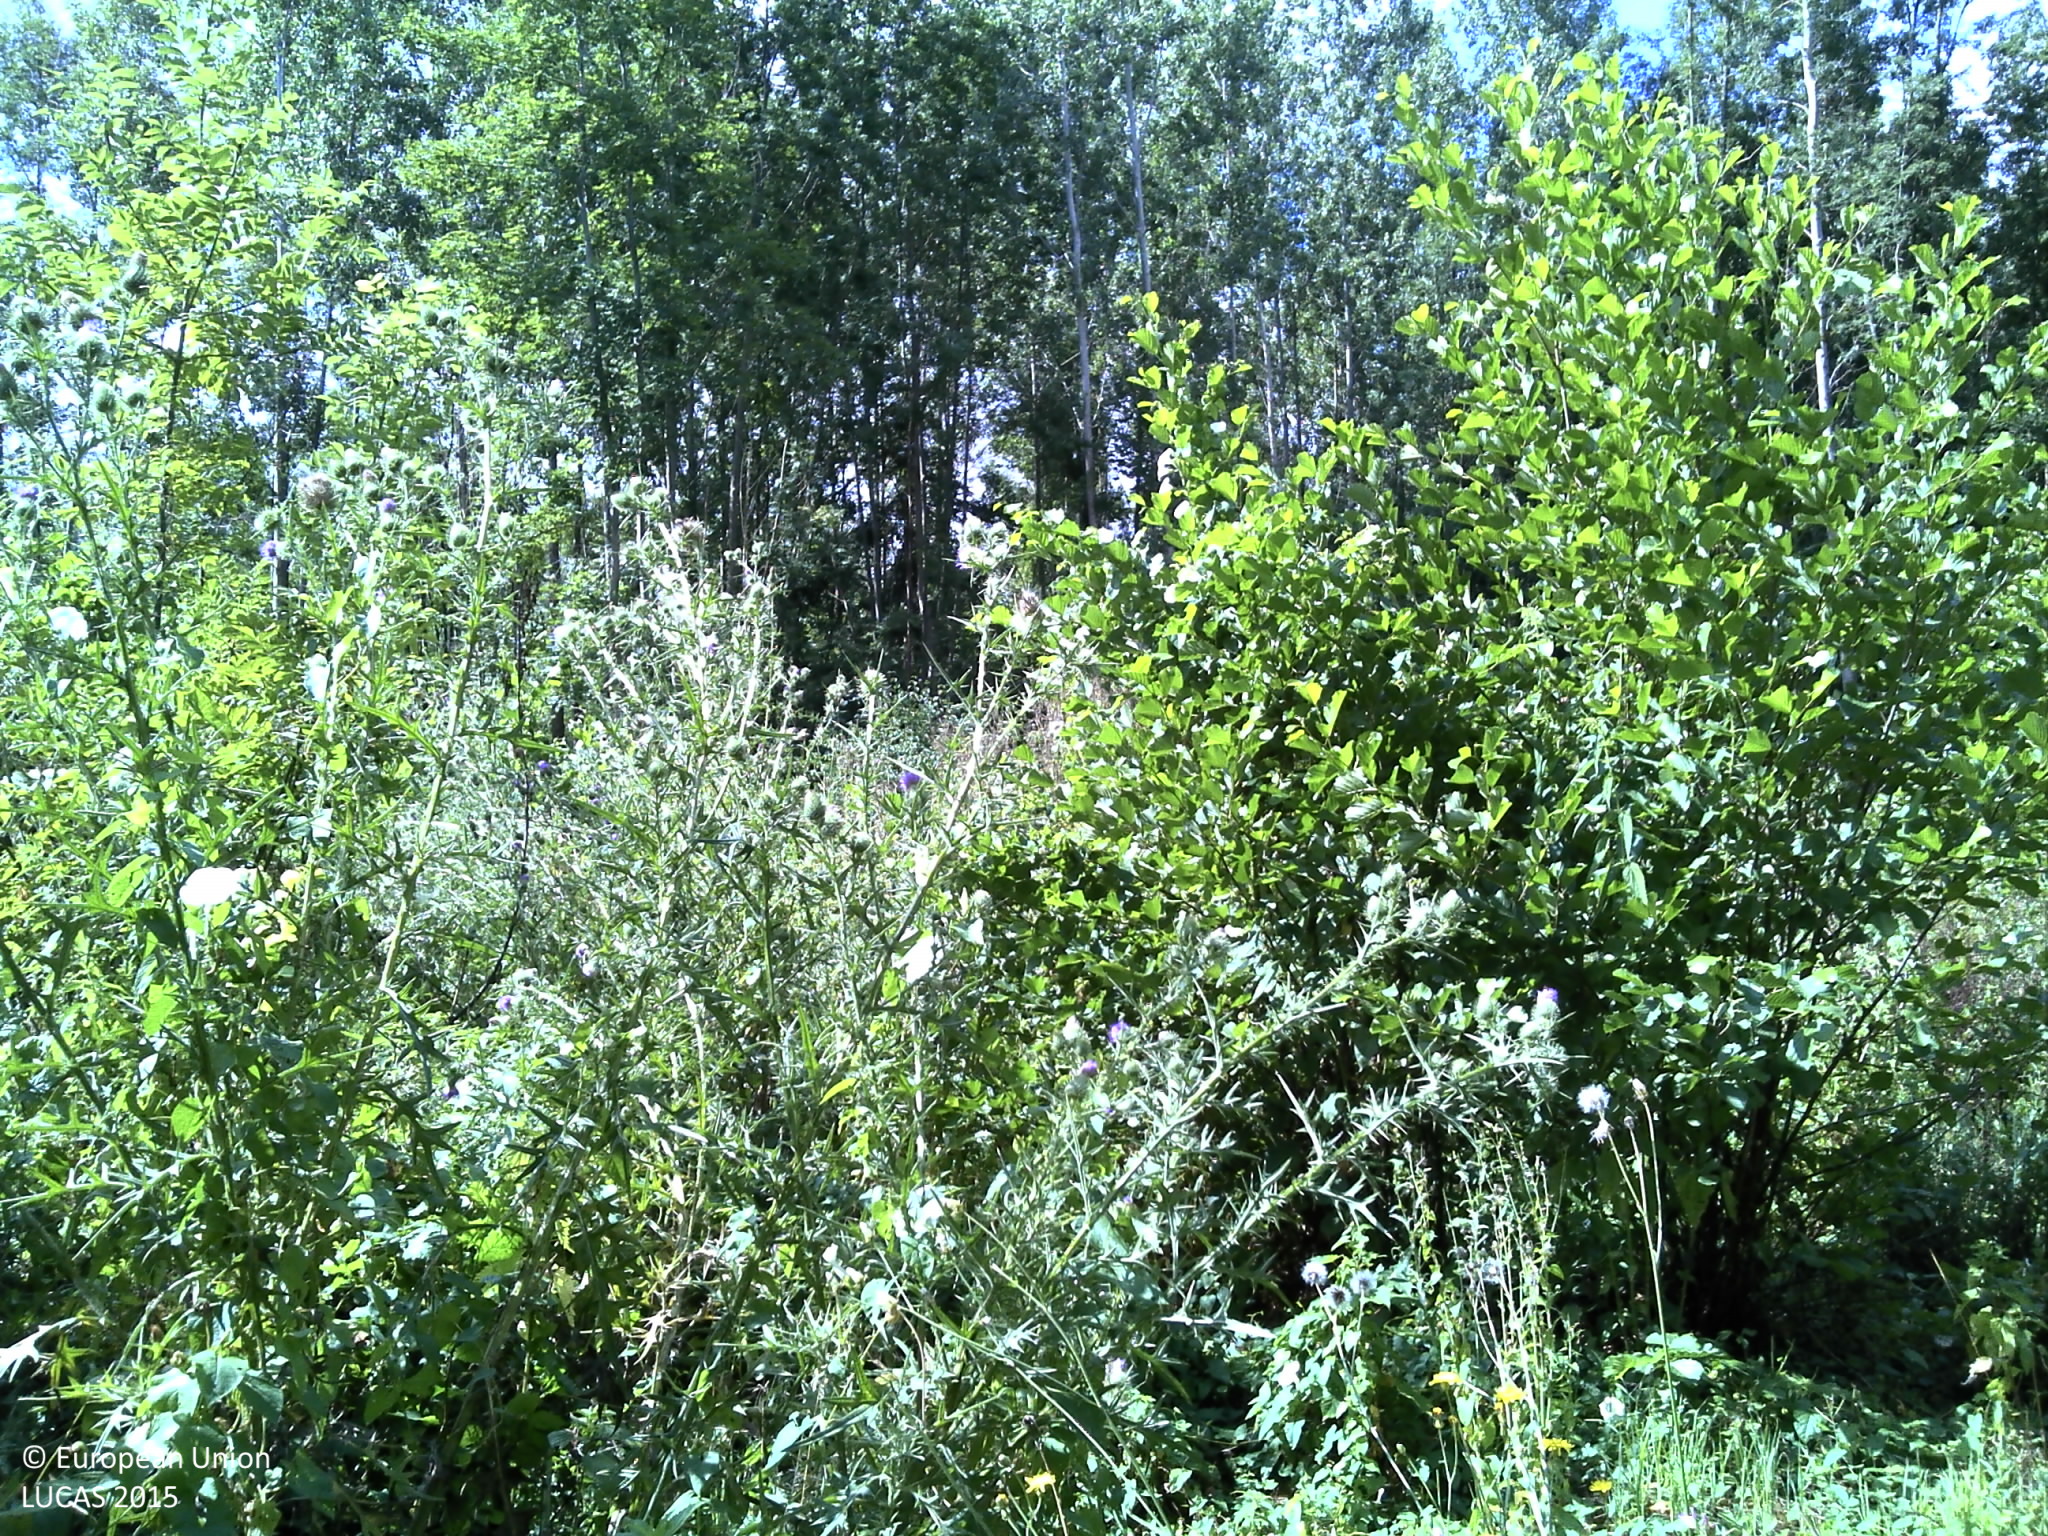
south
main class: Woodland
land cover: Broadleaved woodland
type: beech forest
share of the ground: > 75 %
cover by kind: broadleaved forest trees 80 %, herbaceous plants 20 %
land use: Forestry
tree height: > 5 m
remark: Clear cut
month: July
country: FR
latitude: 48.7622
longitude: 4.6782
